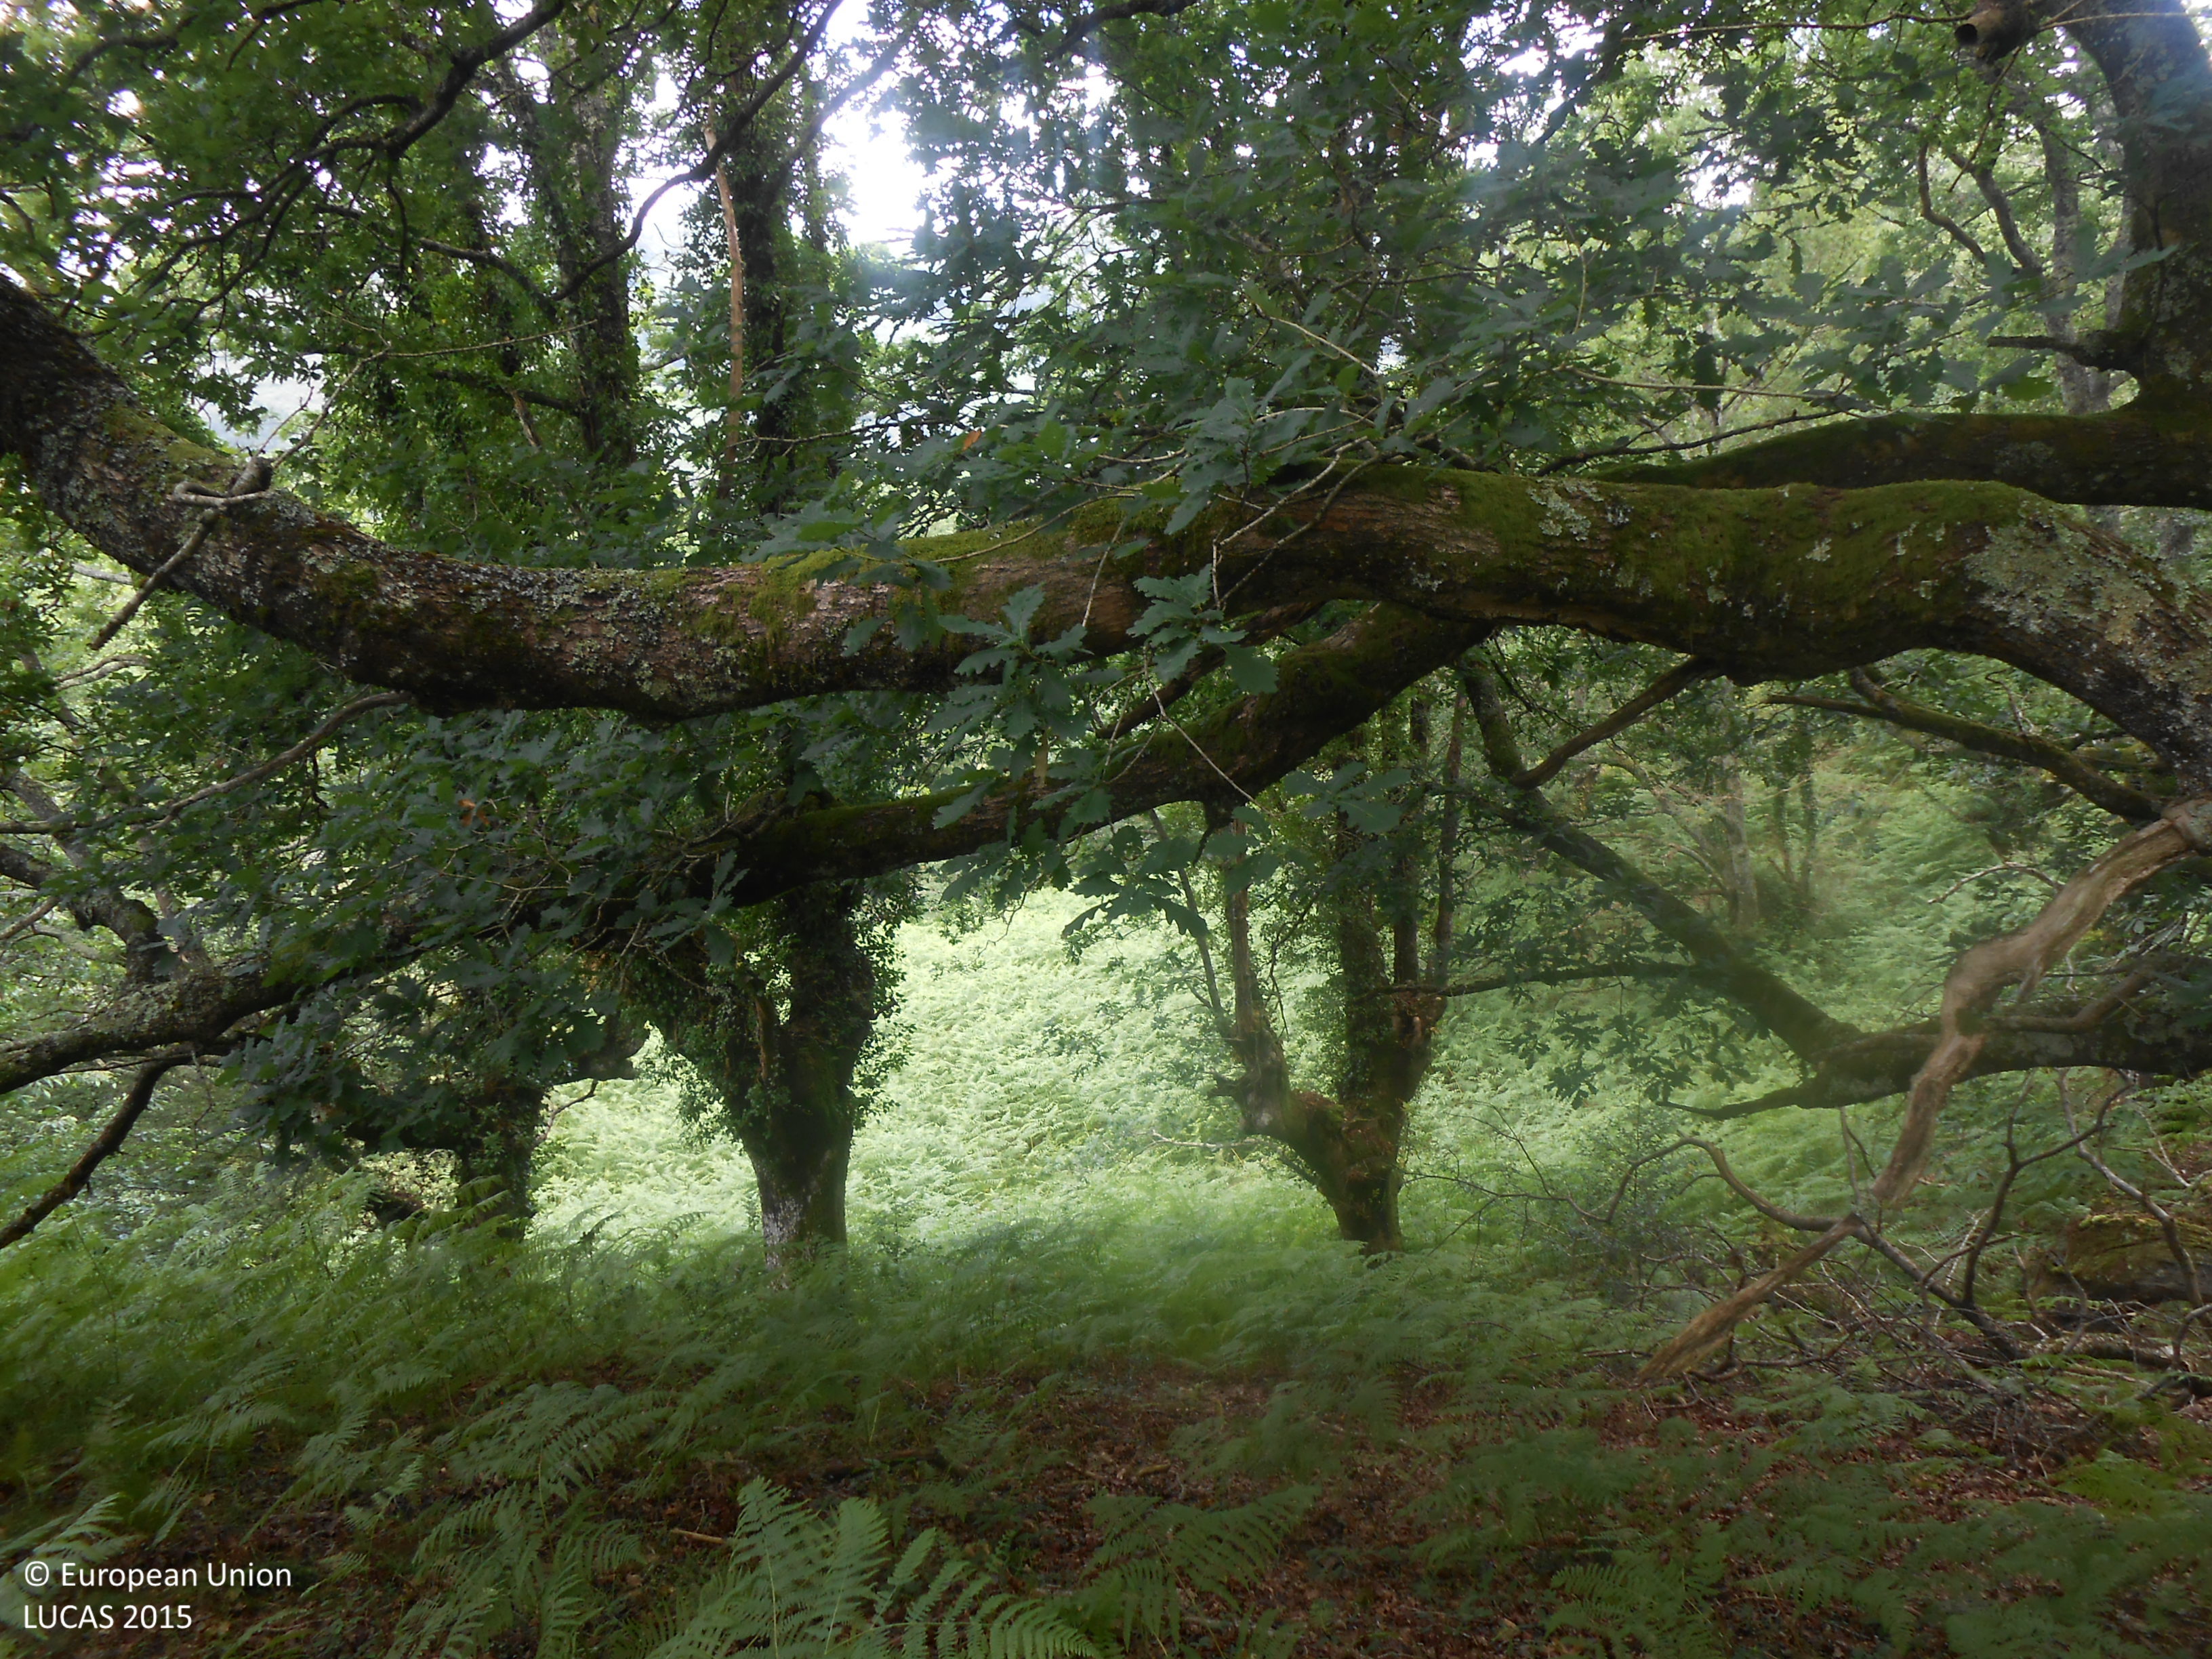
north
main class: Woodland
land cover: Broadleaved woodland
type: acidophilous oak and oak-birch forest
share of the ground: > 75 %
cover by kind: broadleaved forest trees 60 %, herbaceous plants 40 %
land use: Forestry
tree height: > 5 m
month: June
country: ES
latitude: 43.2417
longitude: -1.6062
